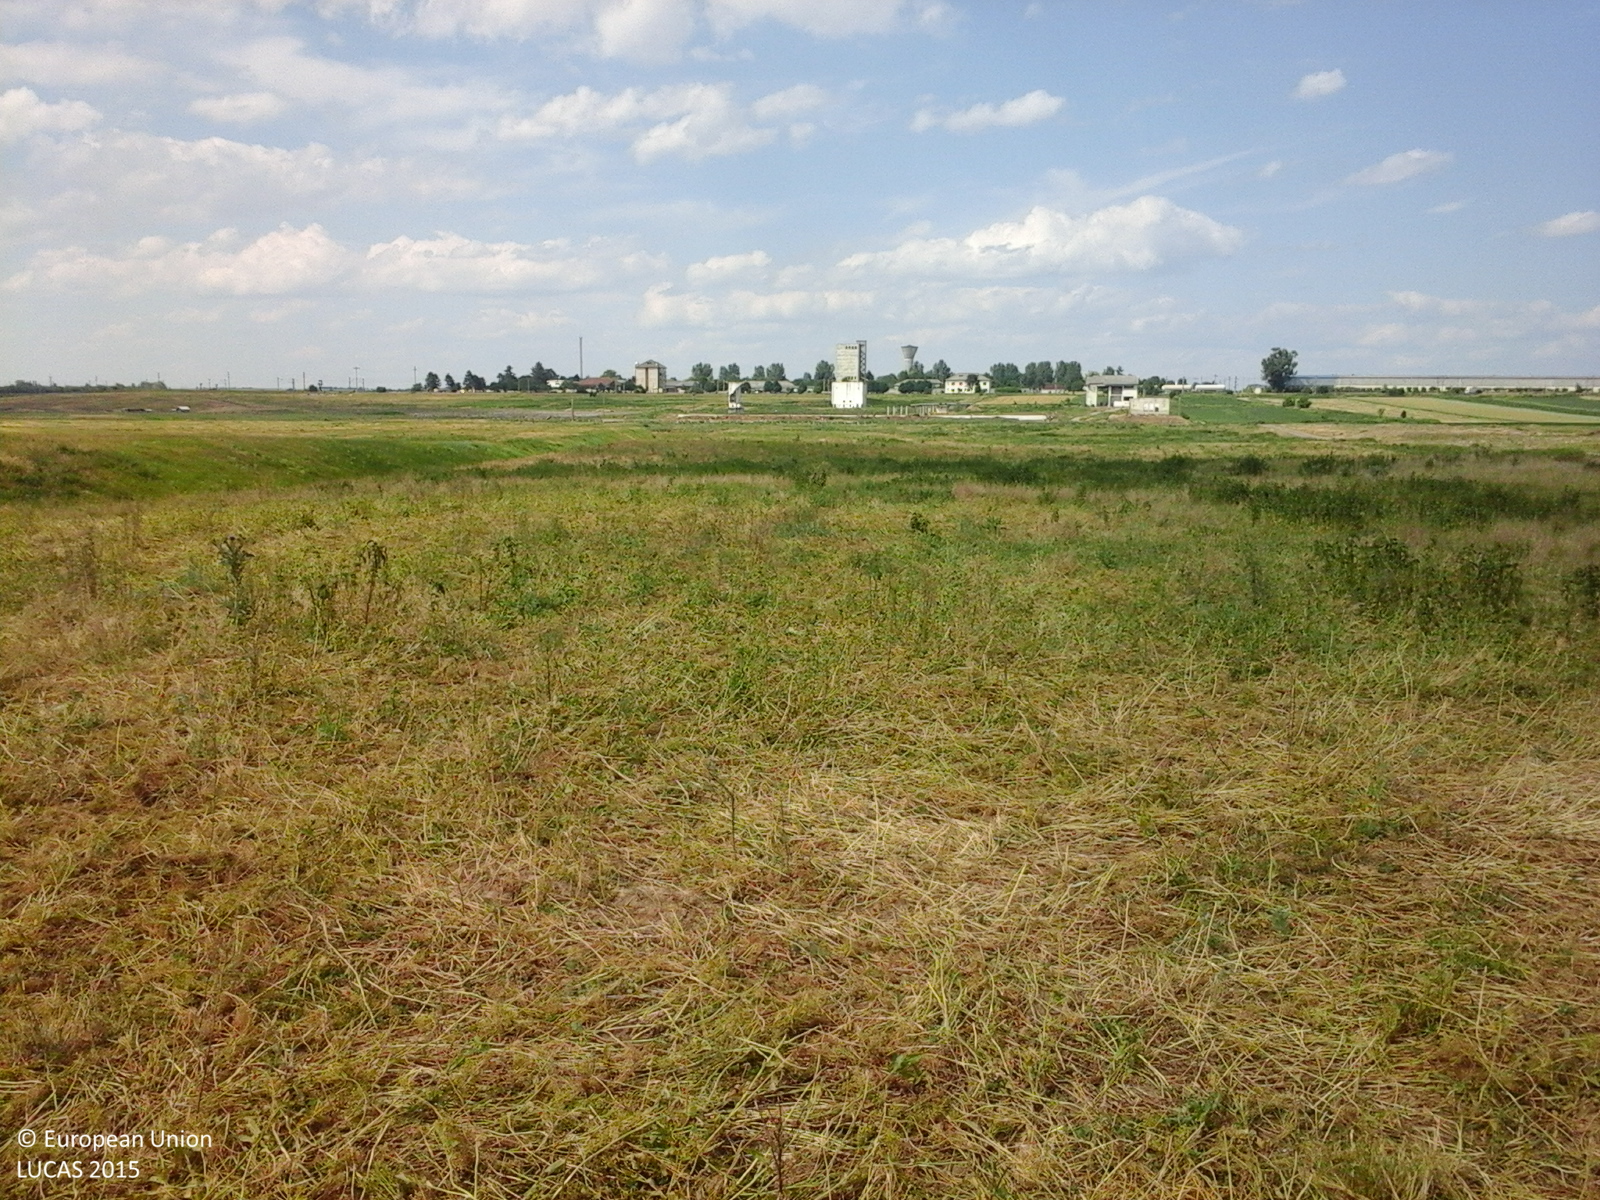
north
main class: Grassland
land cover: Spontaneously vegetated surfaces
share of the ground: > 75 %
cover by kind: herbaceous plants 100 %
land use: Agriculture (excluding fallow land and kitchen gardens)
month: June
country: RO
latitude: 47.6071
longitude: 26.4089
